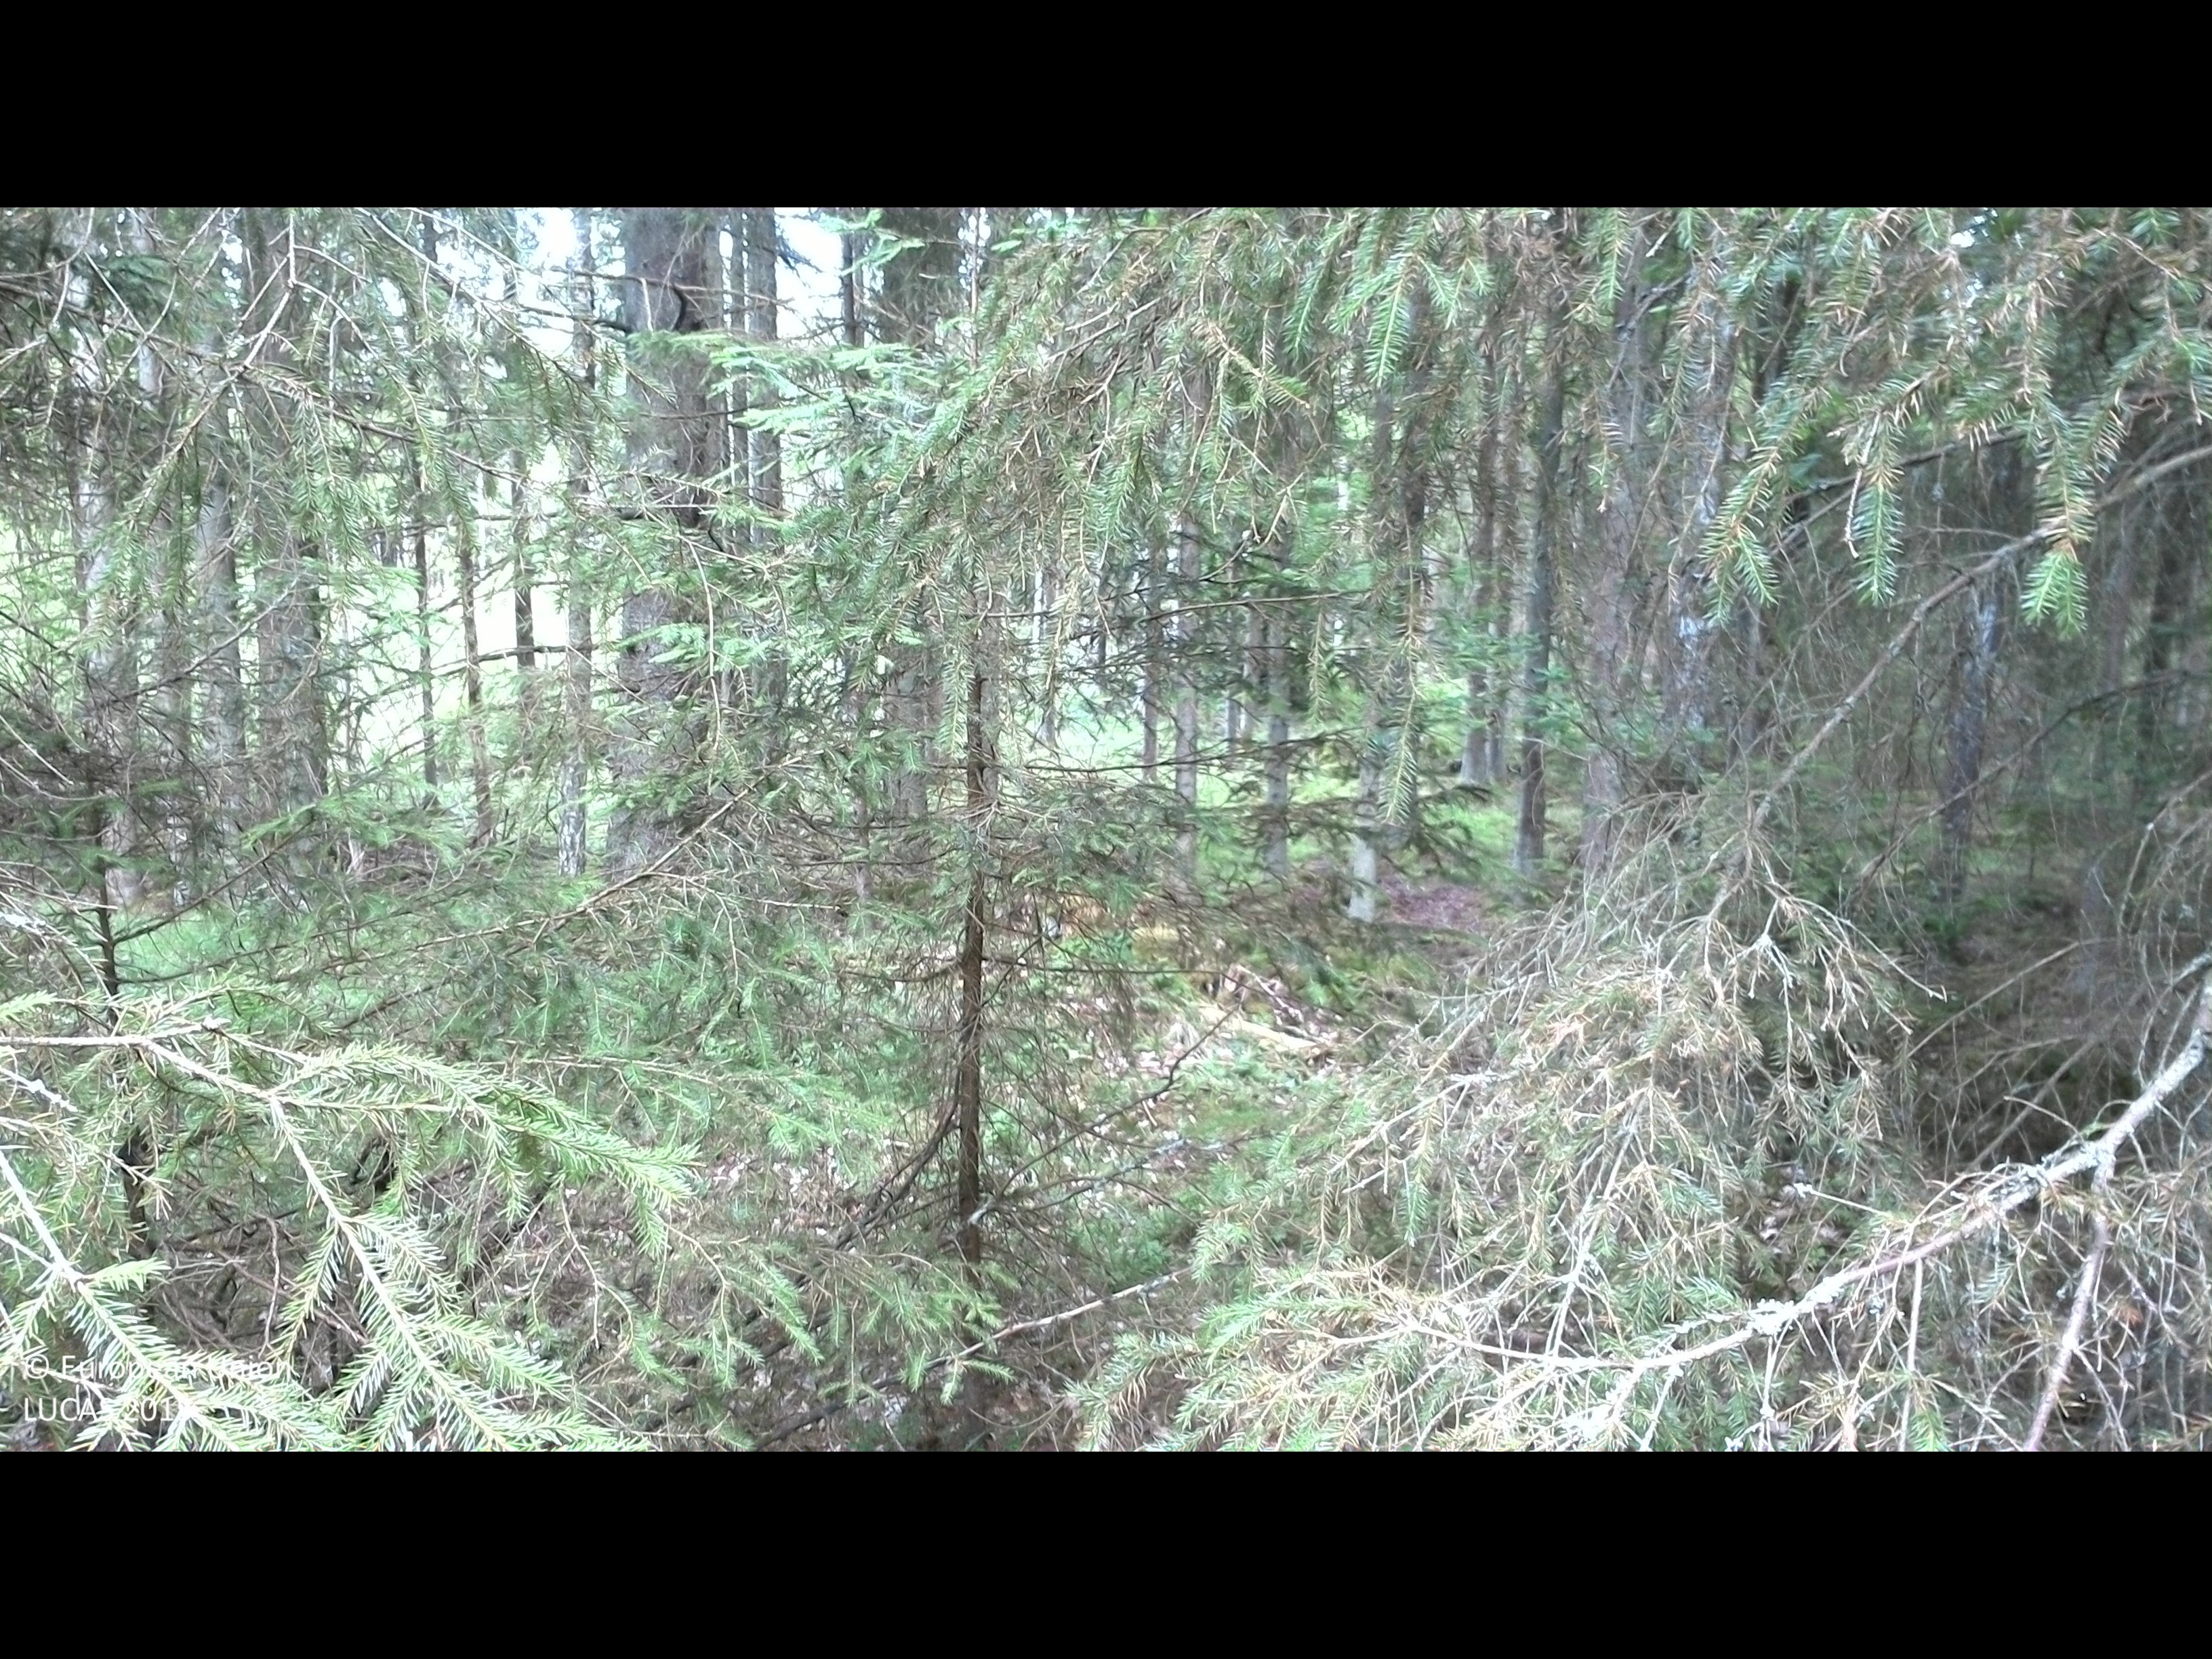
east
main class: Woodland
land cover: Spruce dominated coniferous woodland
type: boreal forest
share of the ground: 50 - 75 %
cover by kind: coniferous forest trees 50 %, shrubs 20 %, herbaceous plants 15 %, lichens and mosses 10 %, broadleaved forest trees 5 %
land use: Forestry
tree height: > 5 m
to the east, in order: Spruce dominated coniferous woodland; Dry stone walls; Spruce dominated coniferous woodland; Spruce dominated mixed woodland; Spruce dominated coniferous woodland
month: July
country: SE
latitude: 56.3311
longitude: 15.2876
